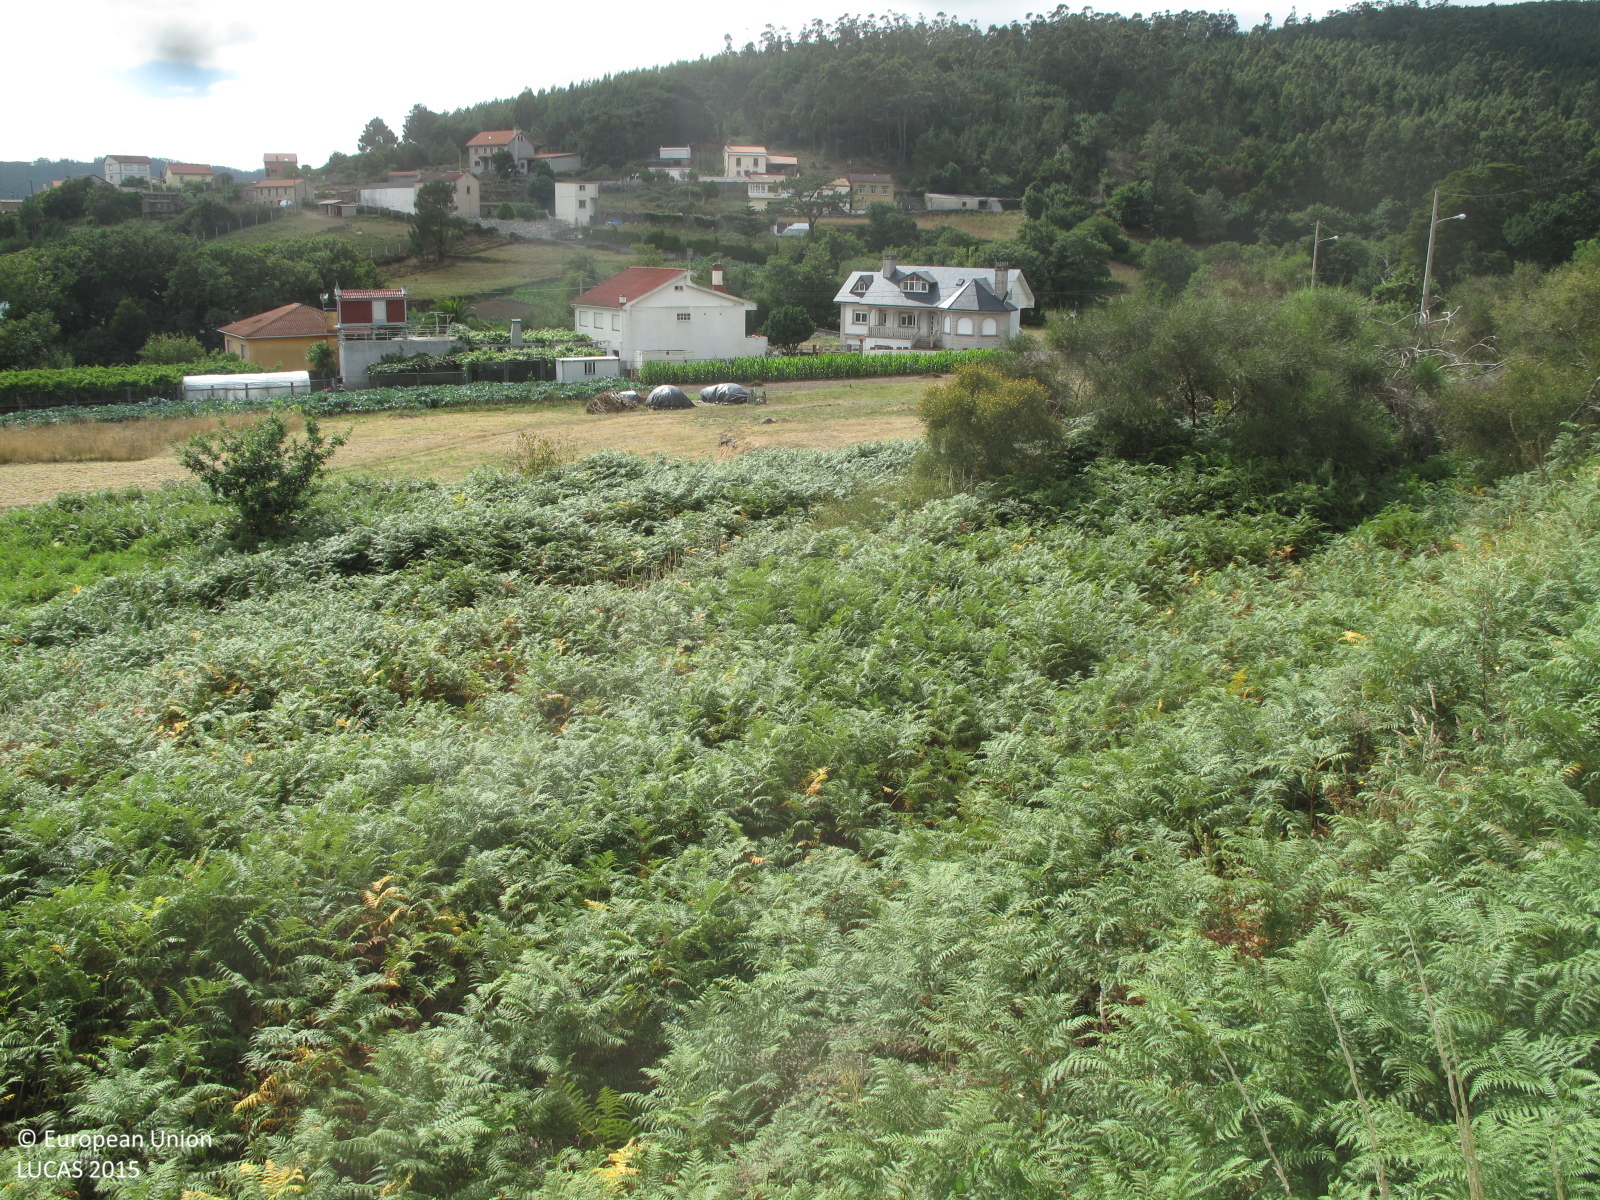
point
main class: Shrubland
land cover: Shrubland without tree cover
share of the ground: > 75 %
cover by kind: shrubs 80 %, herbaceous plants 20 %
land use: Abandoned areas
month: July
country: ES
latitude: 42.9511
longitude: -9.1610
